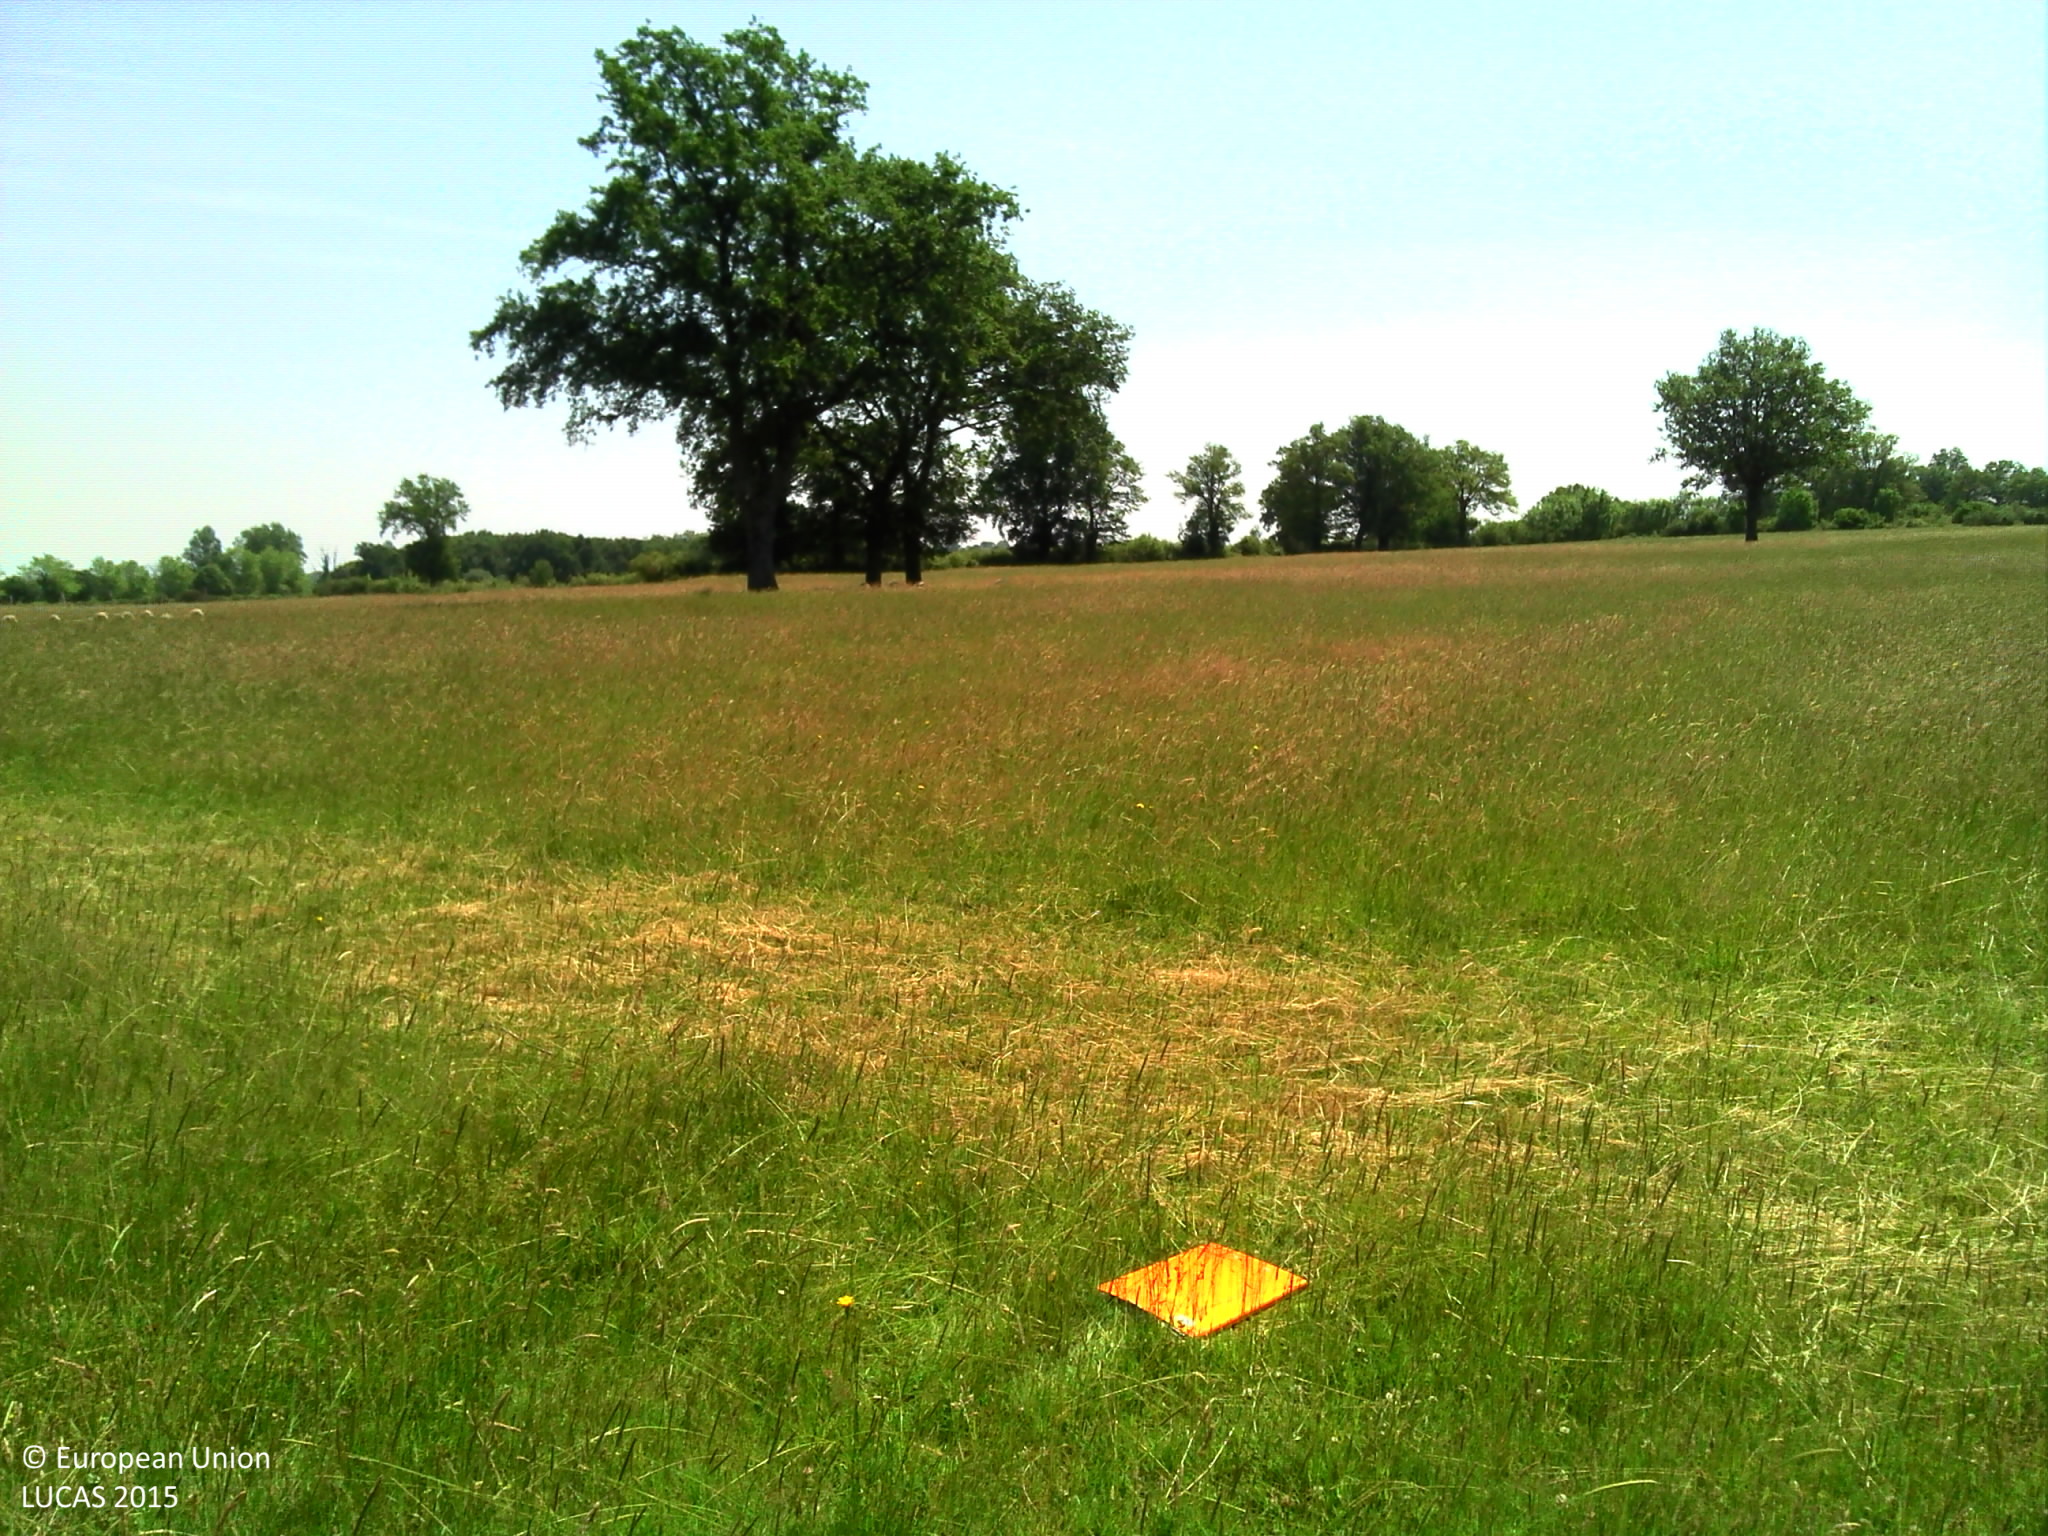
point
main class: Grassland
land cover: Grassland without tree/shrub cover
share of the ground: > 75 %
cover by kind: herbaceous plants 100 %
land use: Agriculture (excluding fallow land and kitchen gardens)
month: June
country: FR
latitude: 46.2888
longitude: 2.7930
